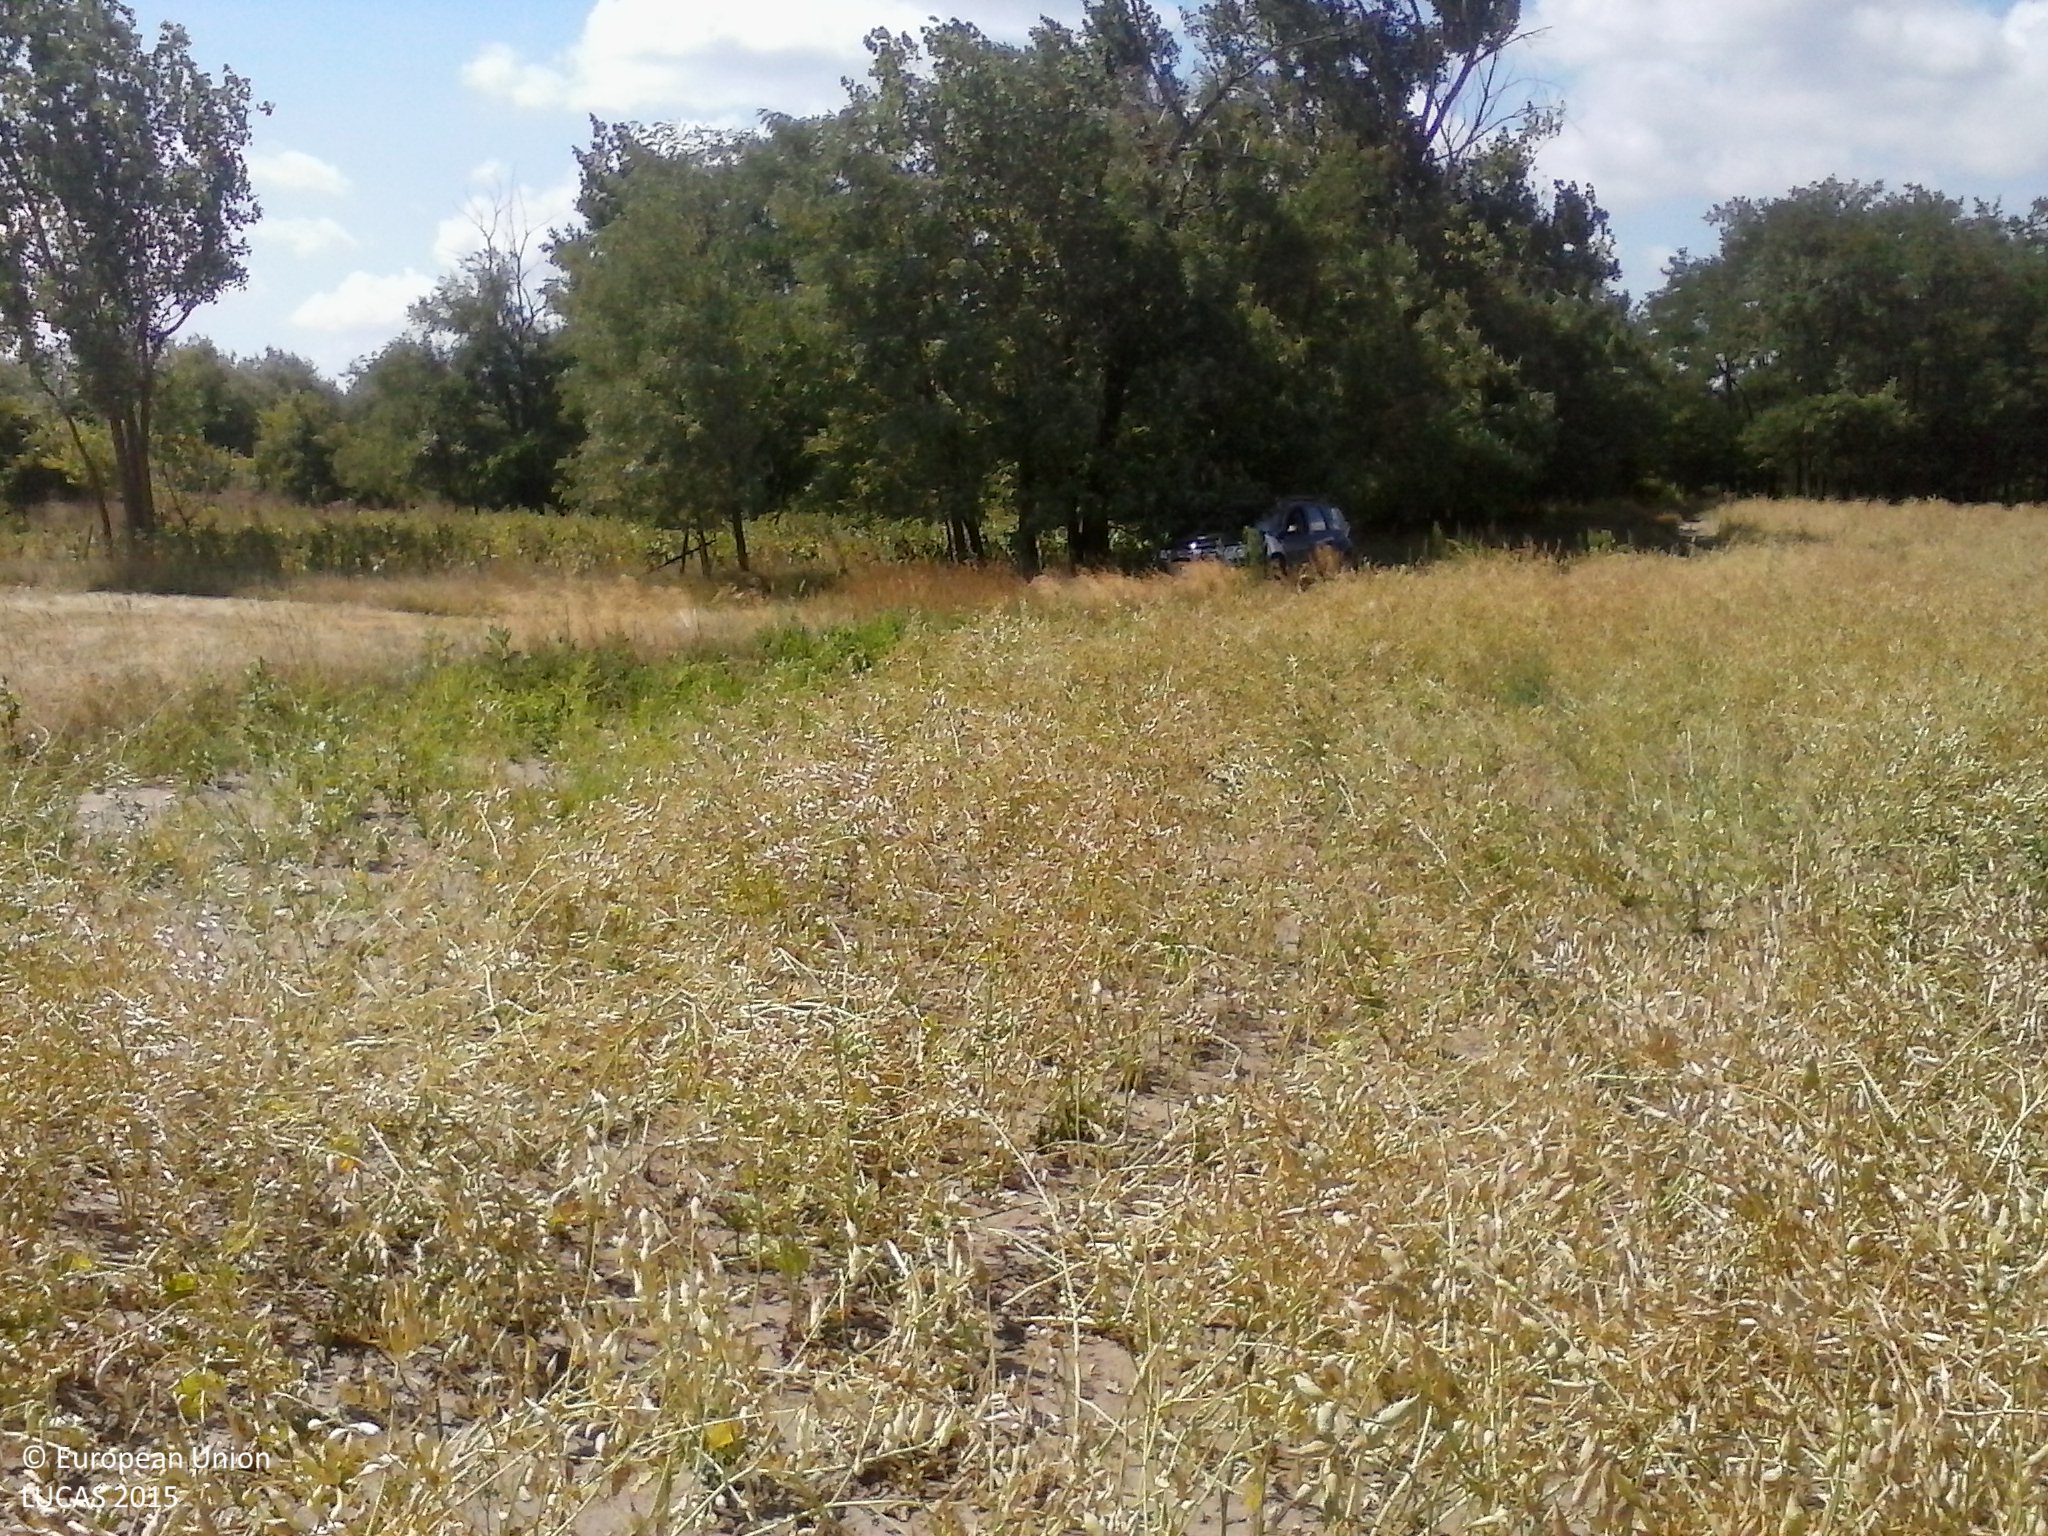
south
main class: Cropland
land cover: Other leguminous and mixtures for fodder
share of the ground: > 75 %
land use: Agriculture (excluding fallow land and kitchen gardens)
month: July
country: HU
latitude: 46.6062
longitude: 19.6147
